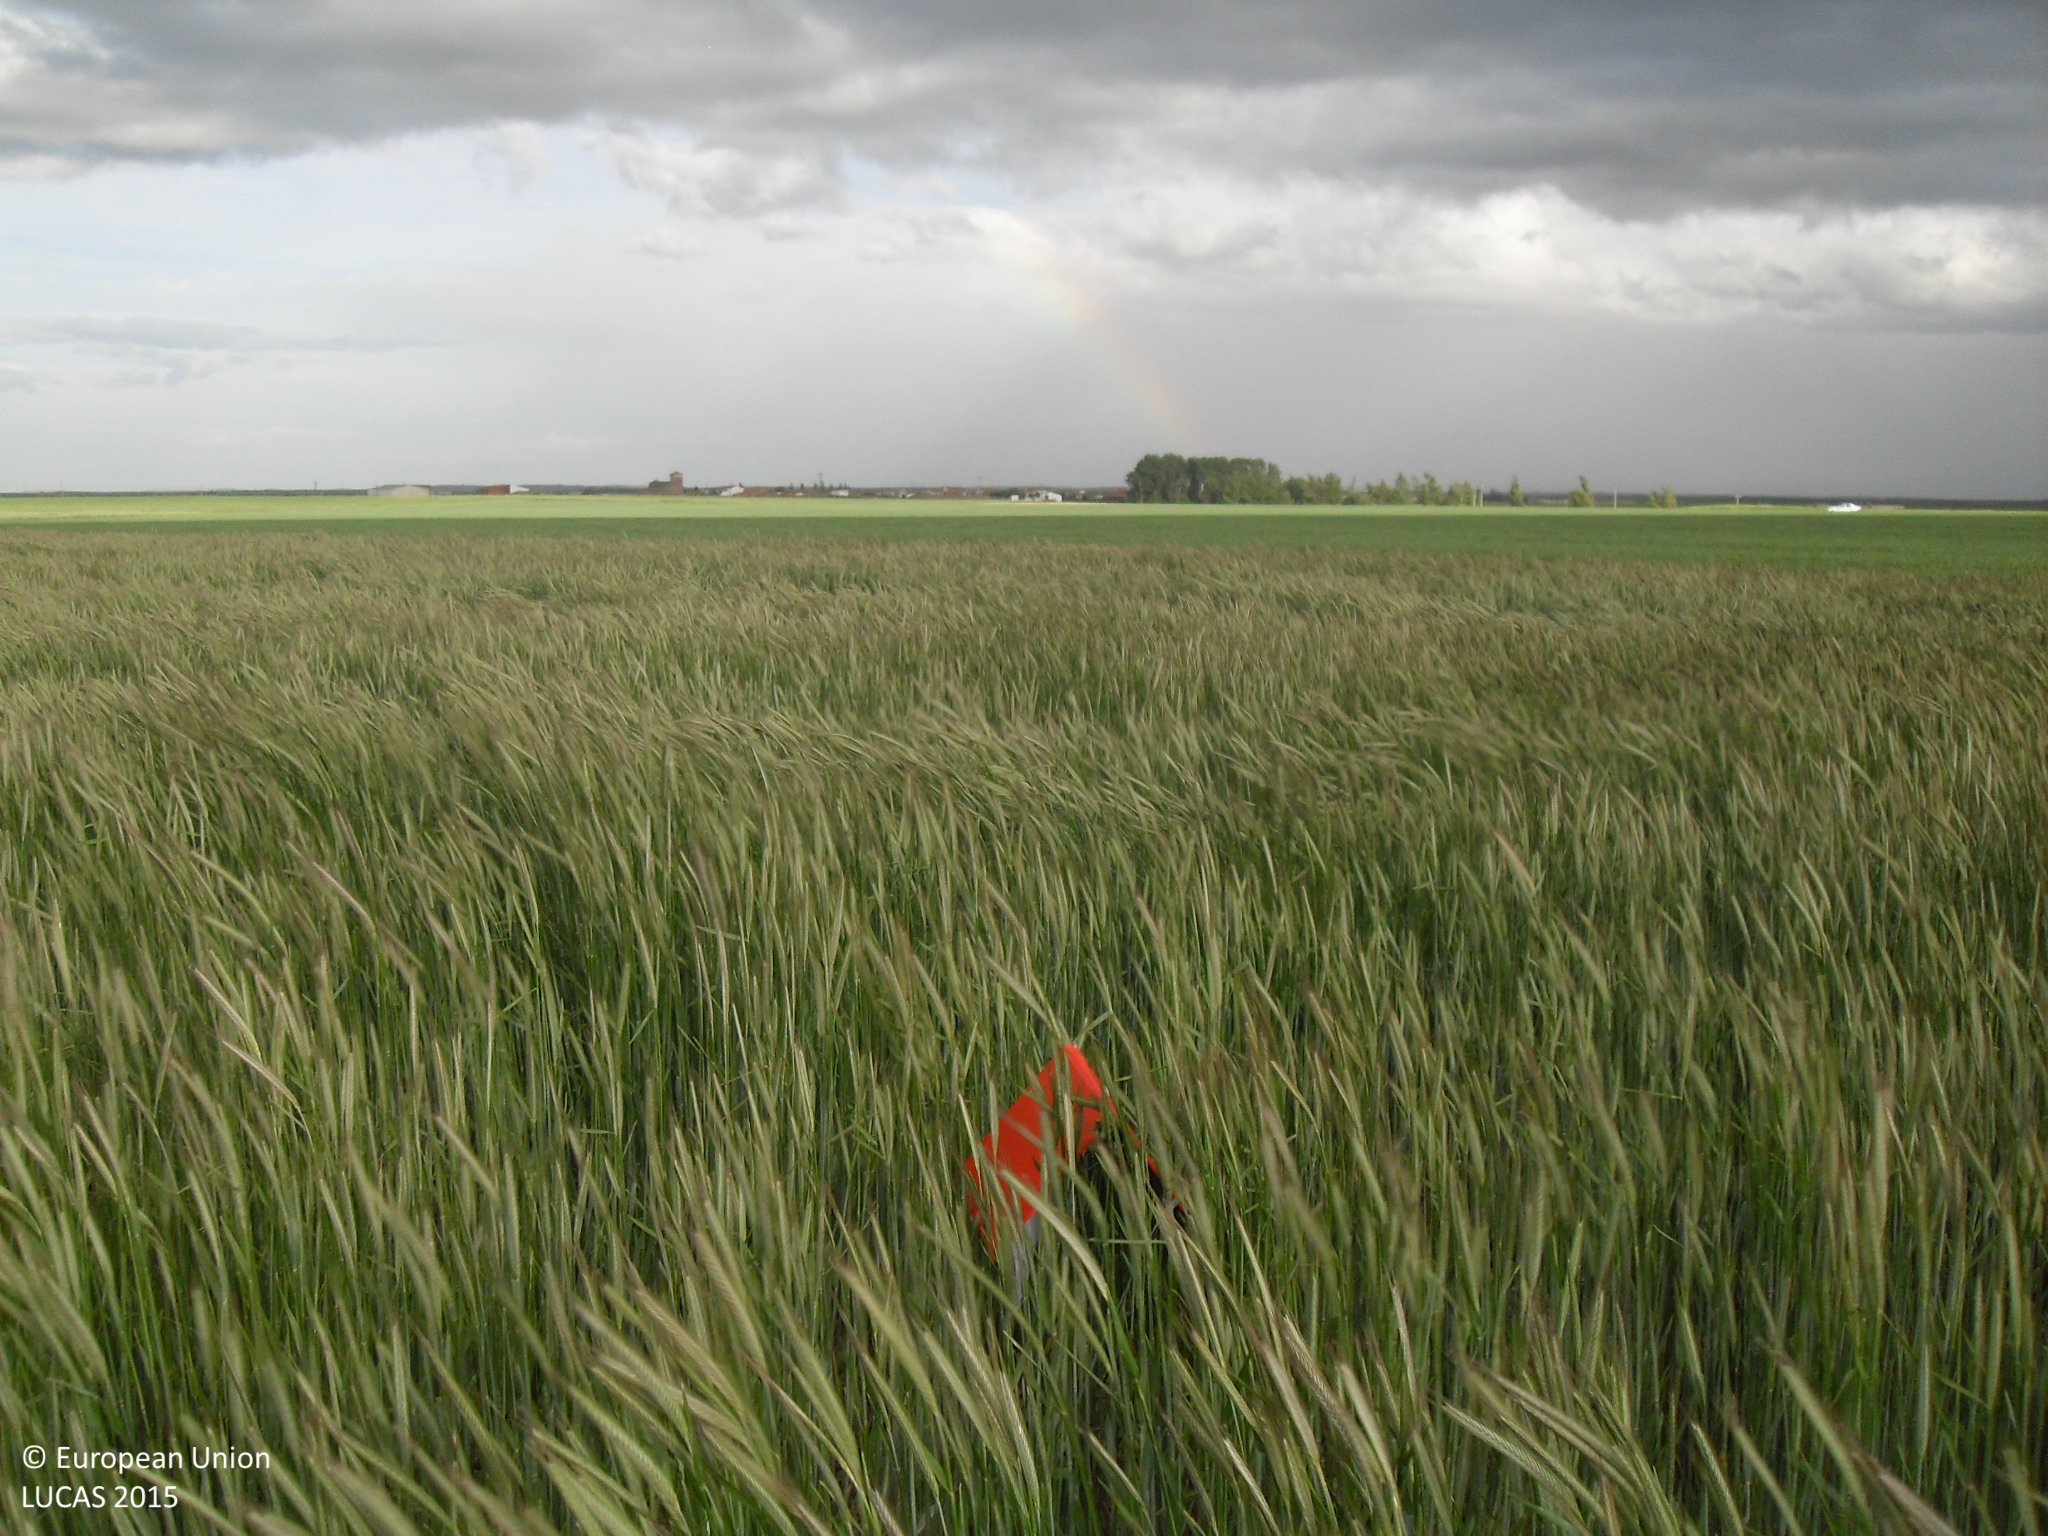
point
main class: Cropland
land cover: Rye
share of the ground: > 75 %
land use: Agriculture (excluding fallow land and kitchen gardens)
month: May
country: ES
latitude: 40.9922
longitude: -5.2738
